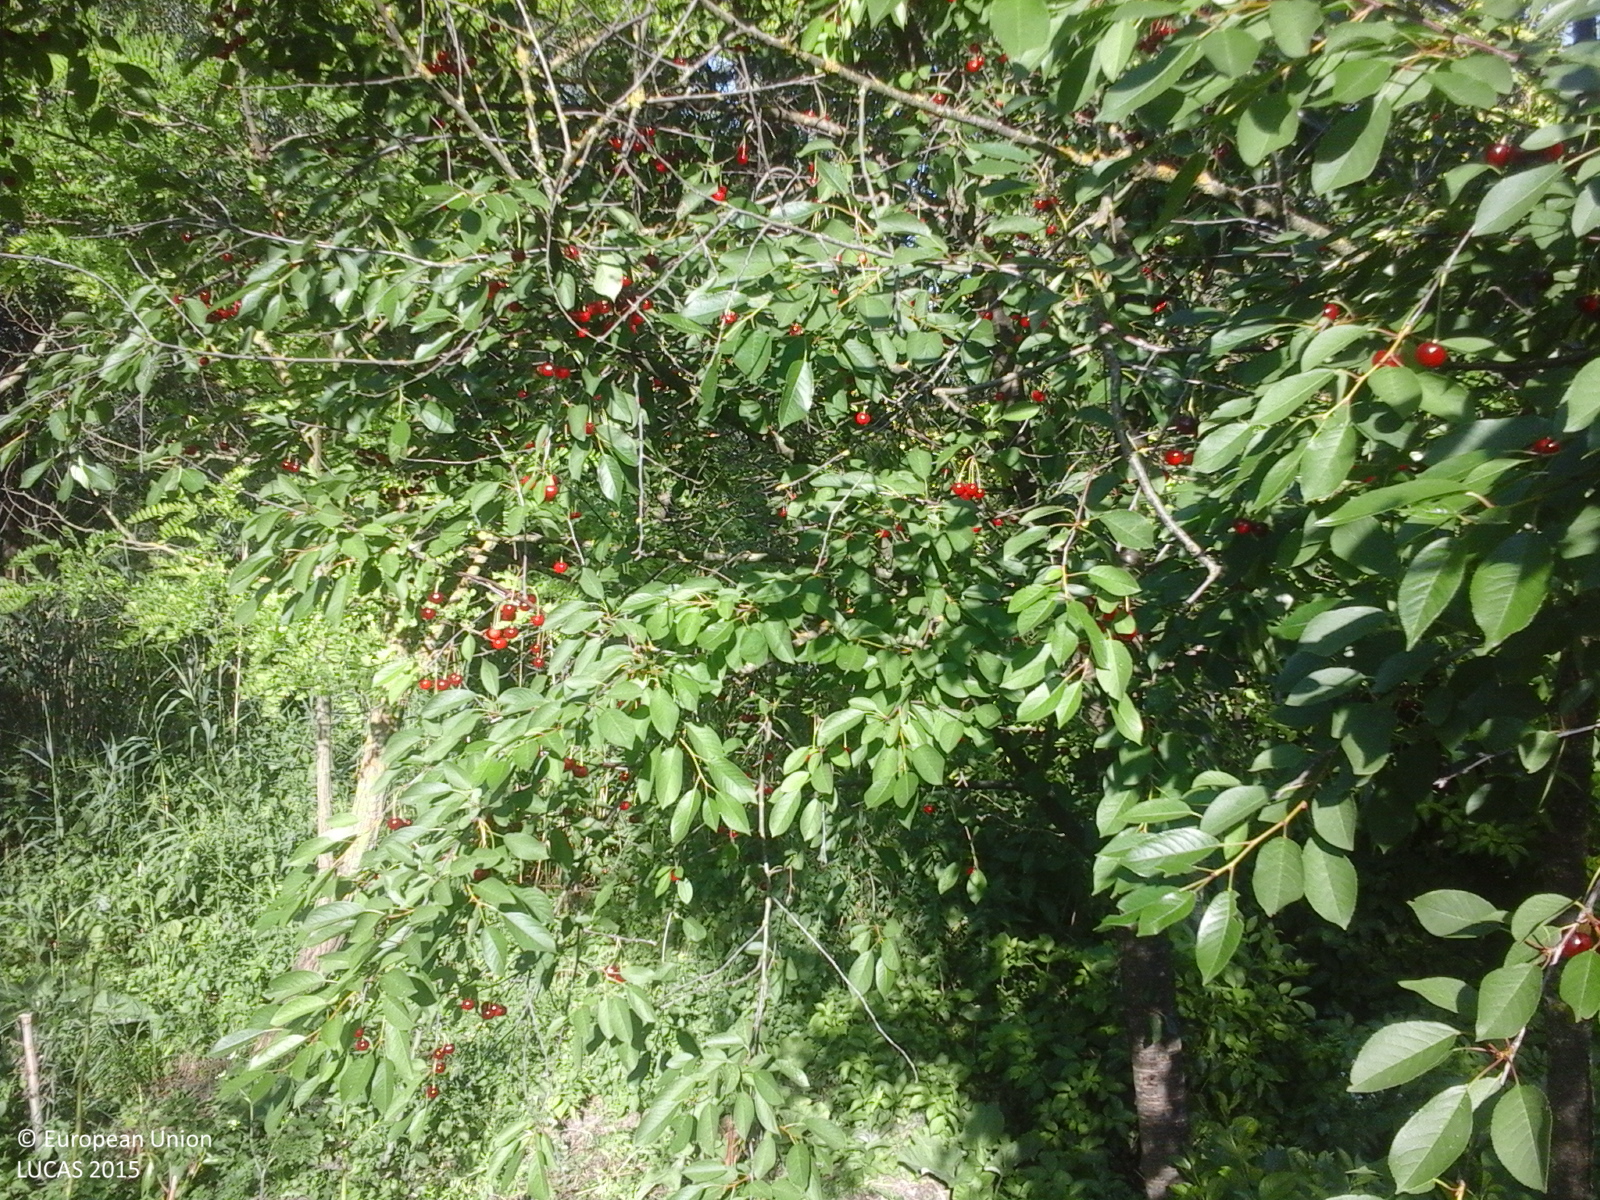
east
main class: Woodland
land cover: Broadleaved woodland
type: broadleaved evergreen forest
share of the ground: > 75 %
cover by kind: broadleaved forest trees 100 %
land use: Forestry
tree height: > 5 m
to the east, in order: Broadleaved woodland; Artificial constructions in urban areas; Maize; Sunflower; Maize; Lucerne; Sunflower; Spontaneously vegetated surfaces; Lucerne; Maize; Broadleaved woodland
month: June
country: RO
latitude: 47.7551
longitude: 27.2266
